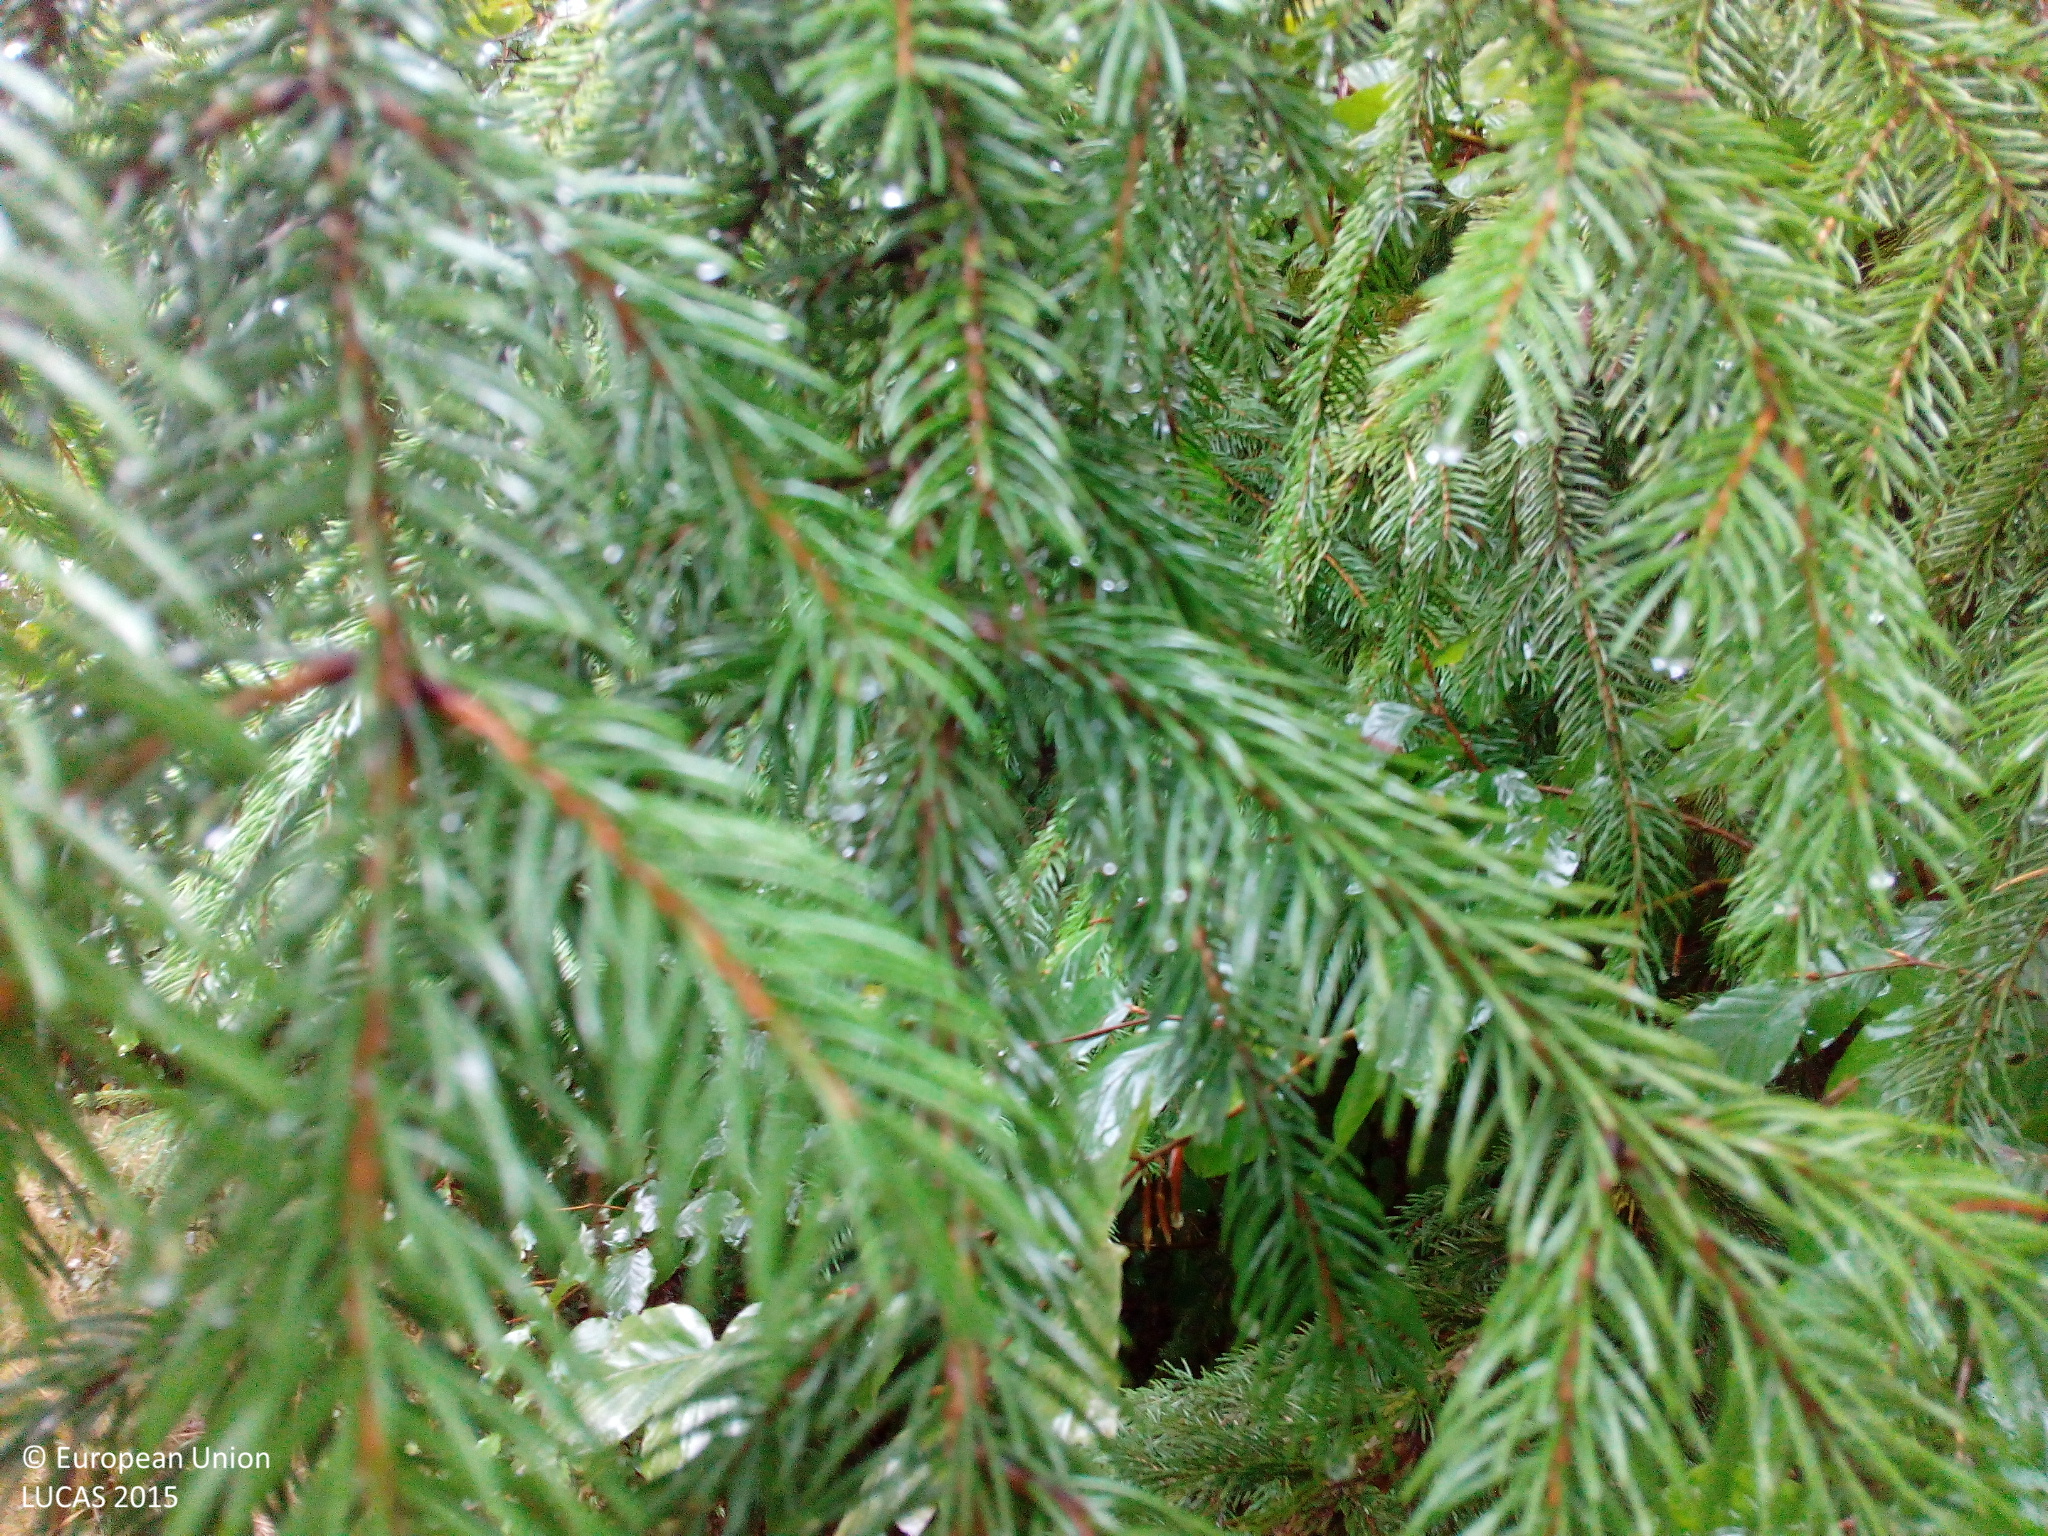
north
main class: Woodland
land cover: Spruce dominated mixed woodland
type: hemiboreal forest and nemoral coniferous forest and mixed broadleaved-coniferous forest
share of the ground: > 75 %
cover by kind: coniferous forest trees 60 %, broadleaved forest trees 40 %
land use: Forestry
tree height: < 5 m
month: September
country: DE
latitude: 49.9318
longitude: 9.5961
